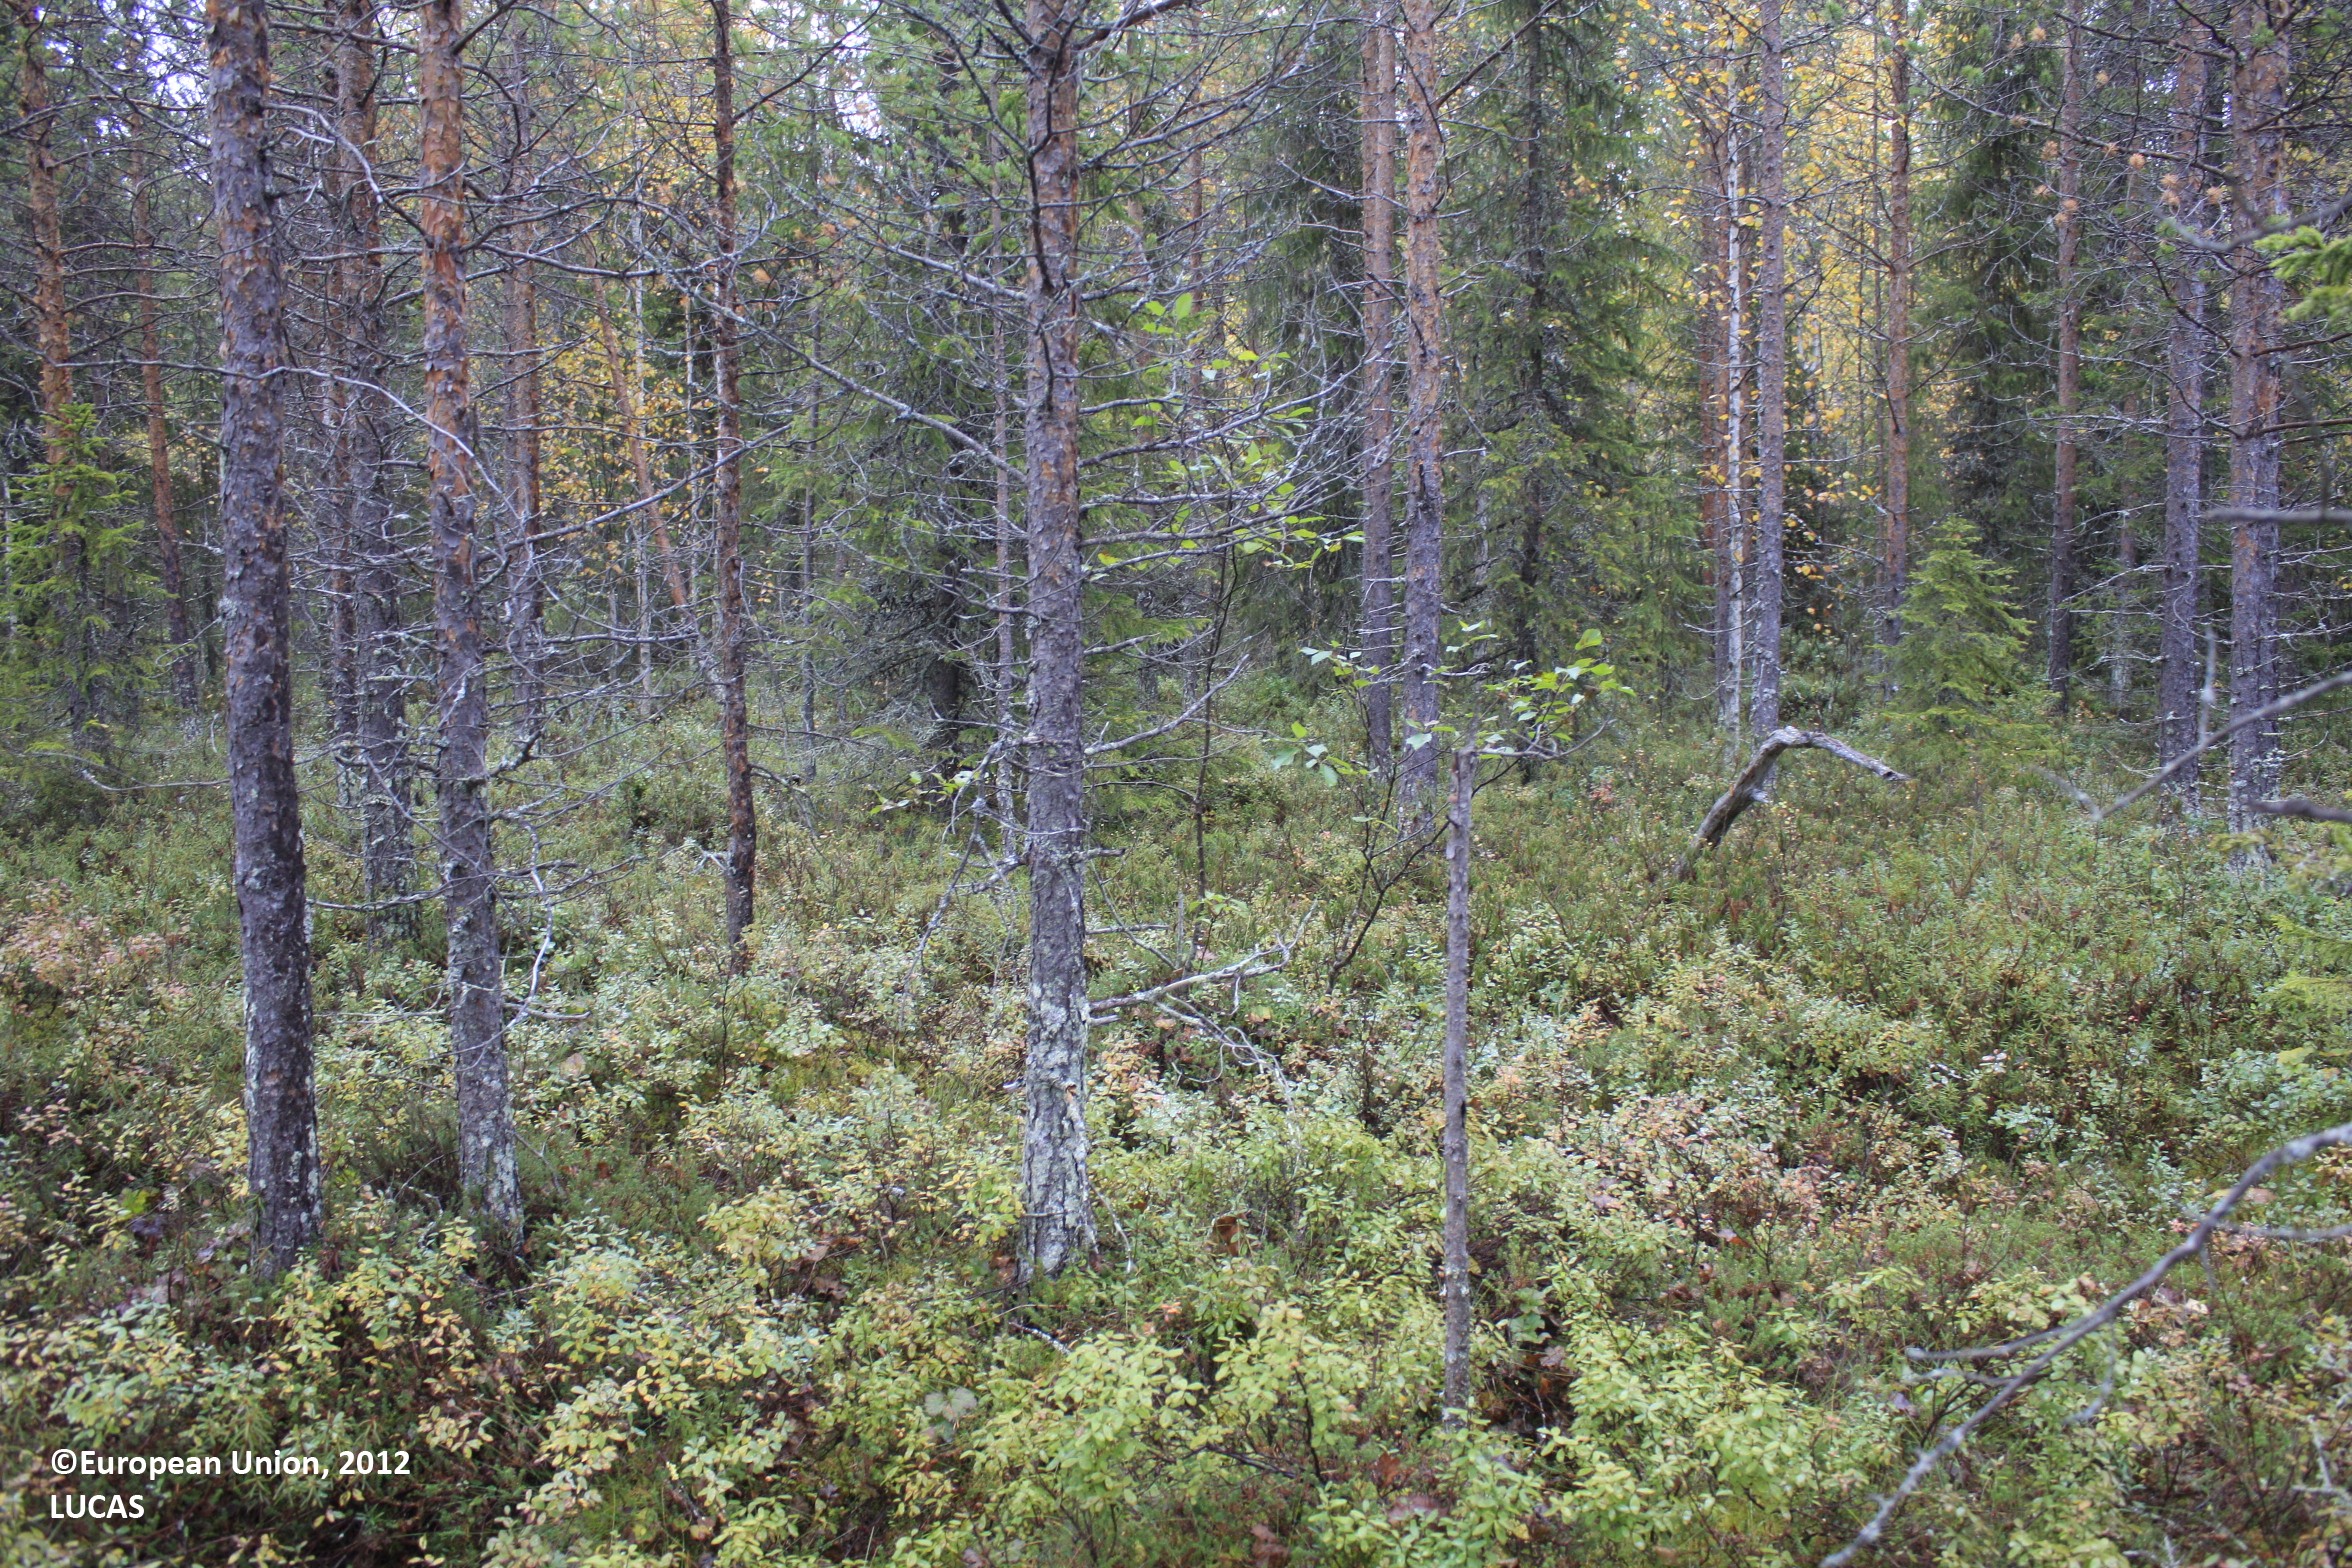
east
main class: Woodland
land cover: Pine dominated coniferous woodland
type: boreal forest
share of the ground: 25 - 50 %
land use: Forestry
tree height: > 5 m
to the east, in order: Pine dominated coniferous woodland
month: September
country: FI
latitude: 65.7325
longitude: 27.2353
